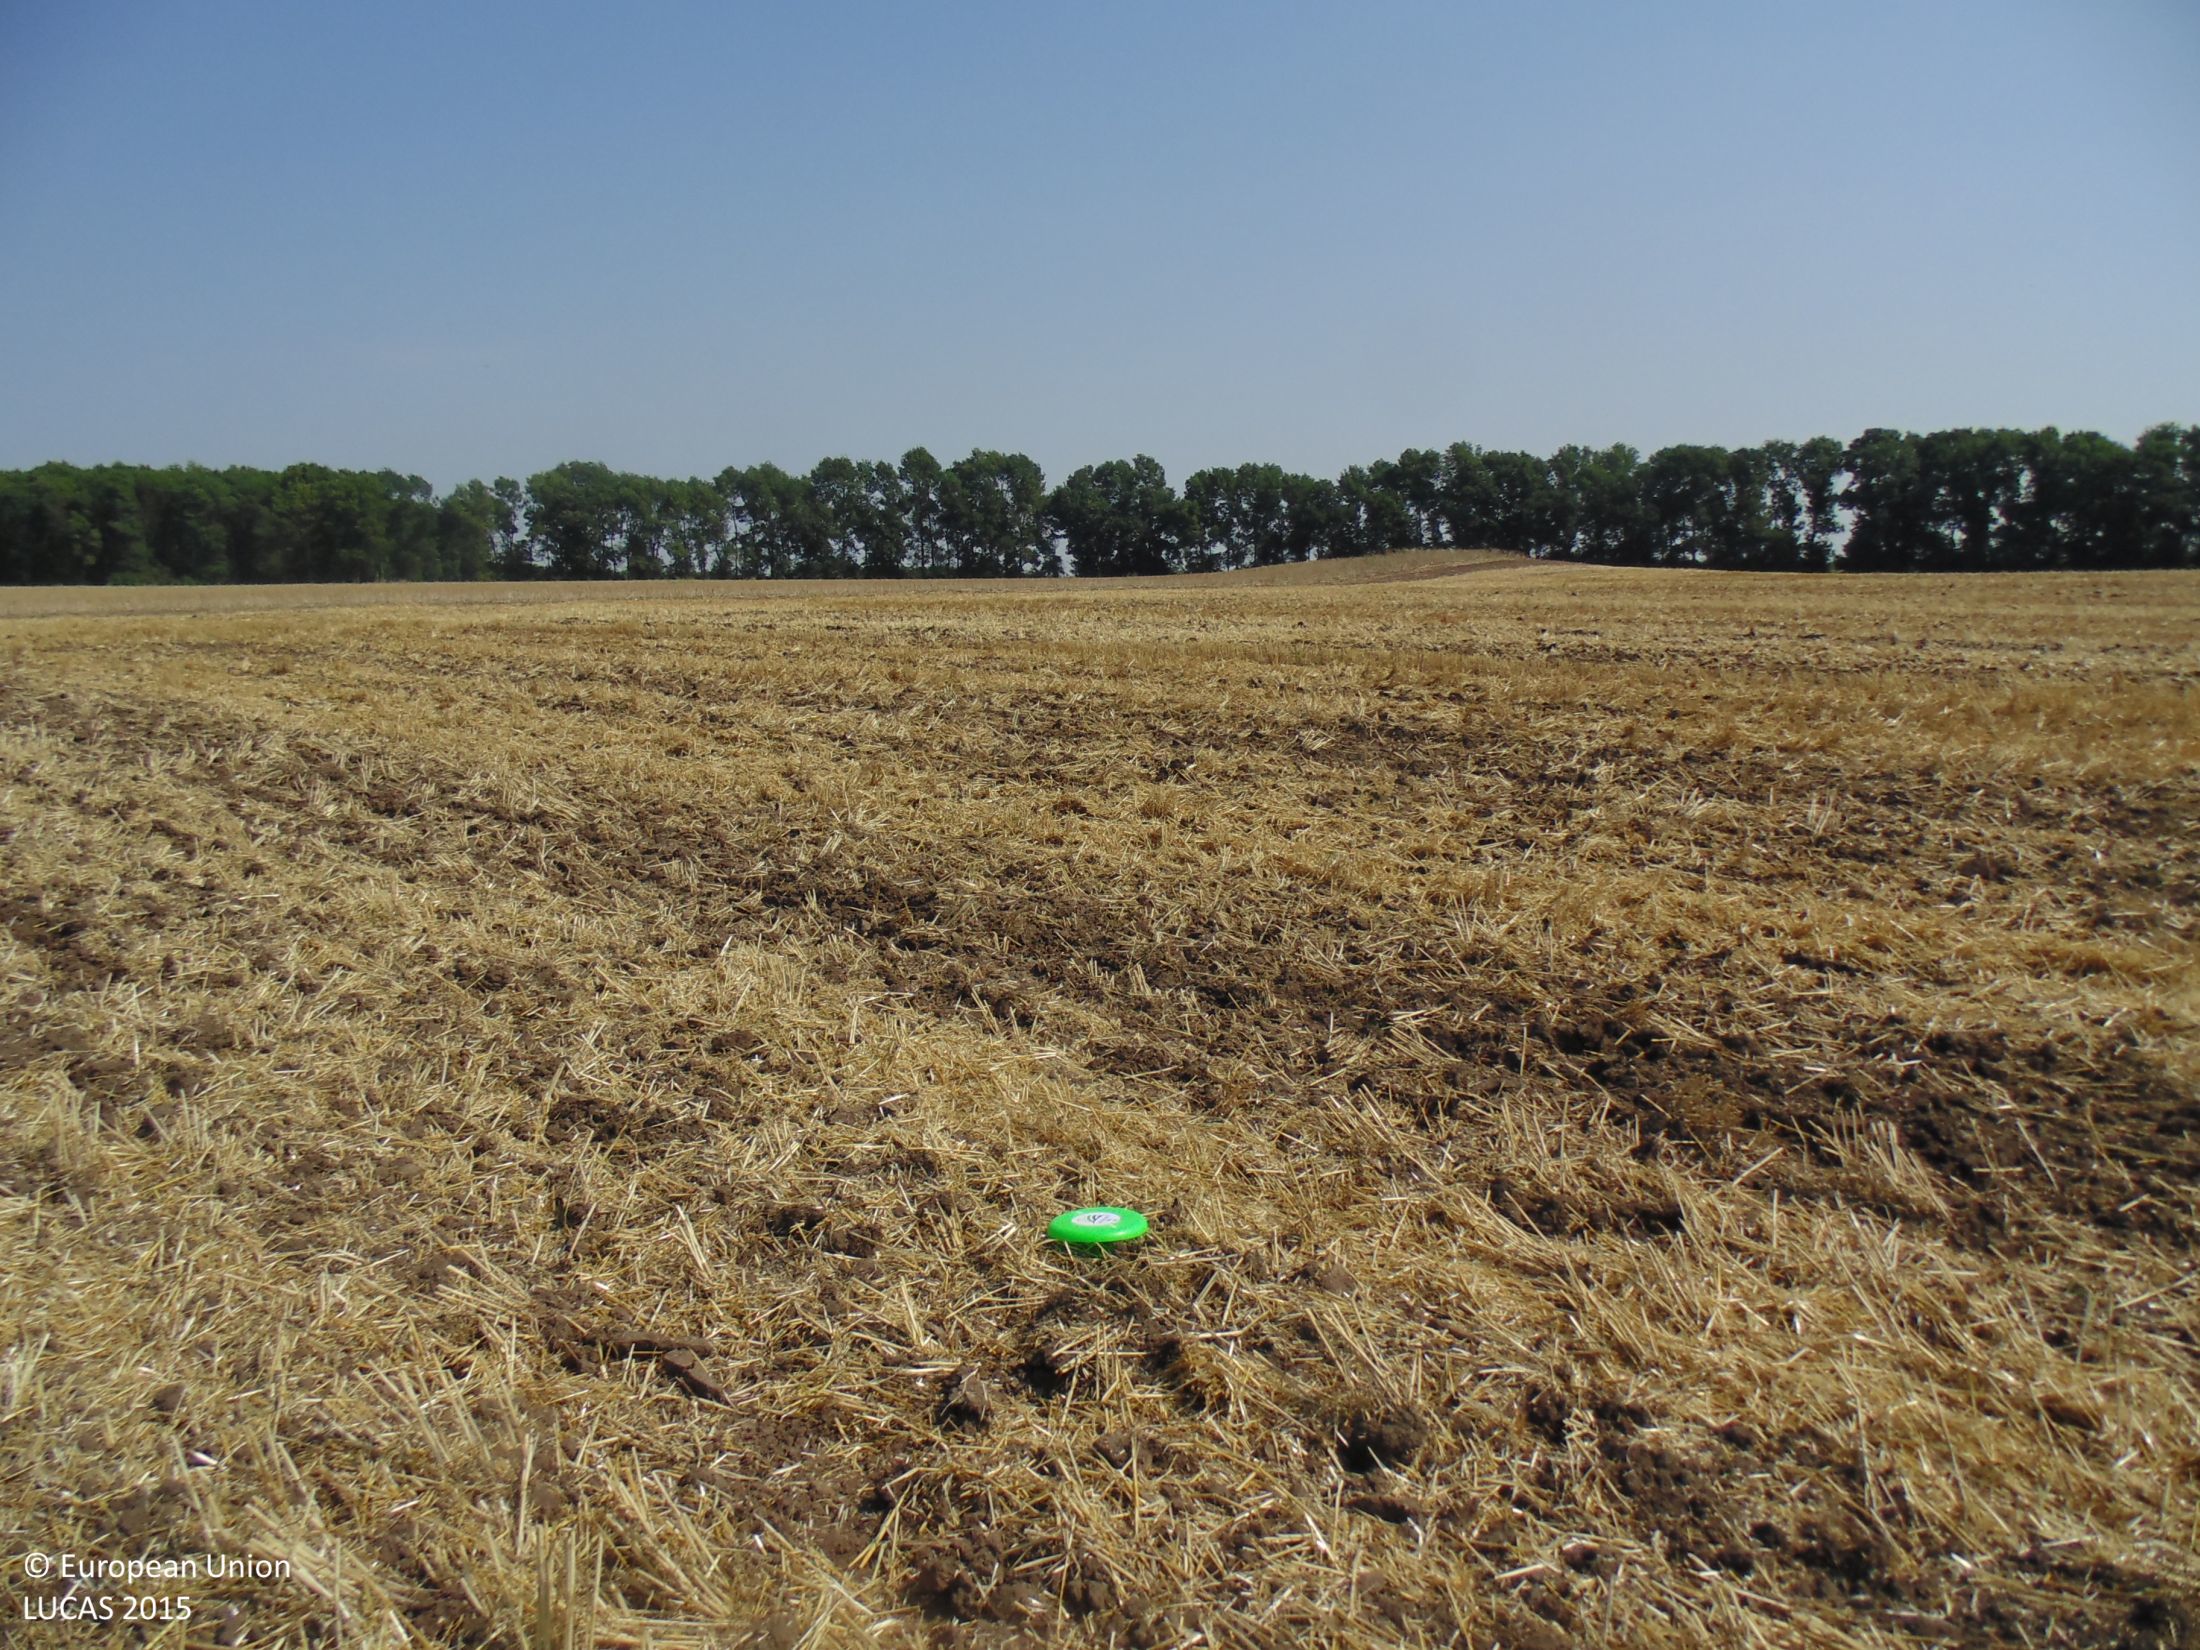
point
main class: Cropland
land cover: Common wheat
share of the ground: 10 - 25 %
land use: Agriculture (excluding fallow land and kitchen gardens)
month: July
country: BG
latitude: 43.5084
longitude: 27.9433
